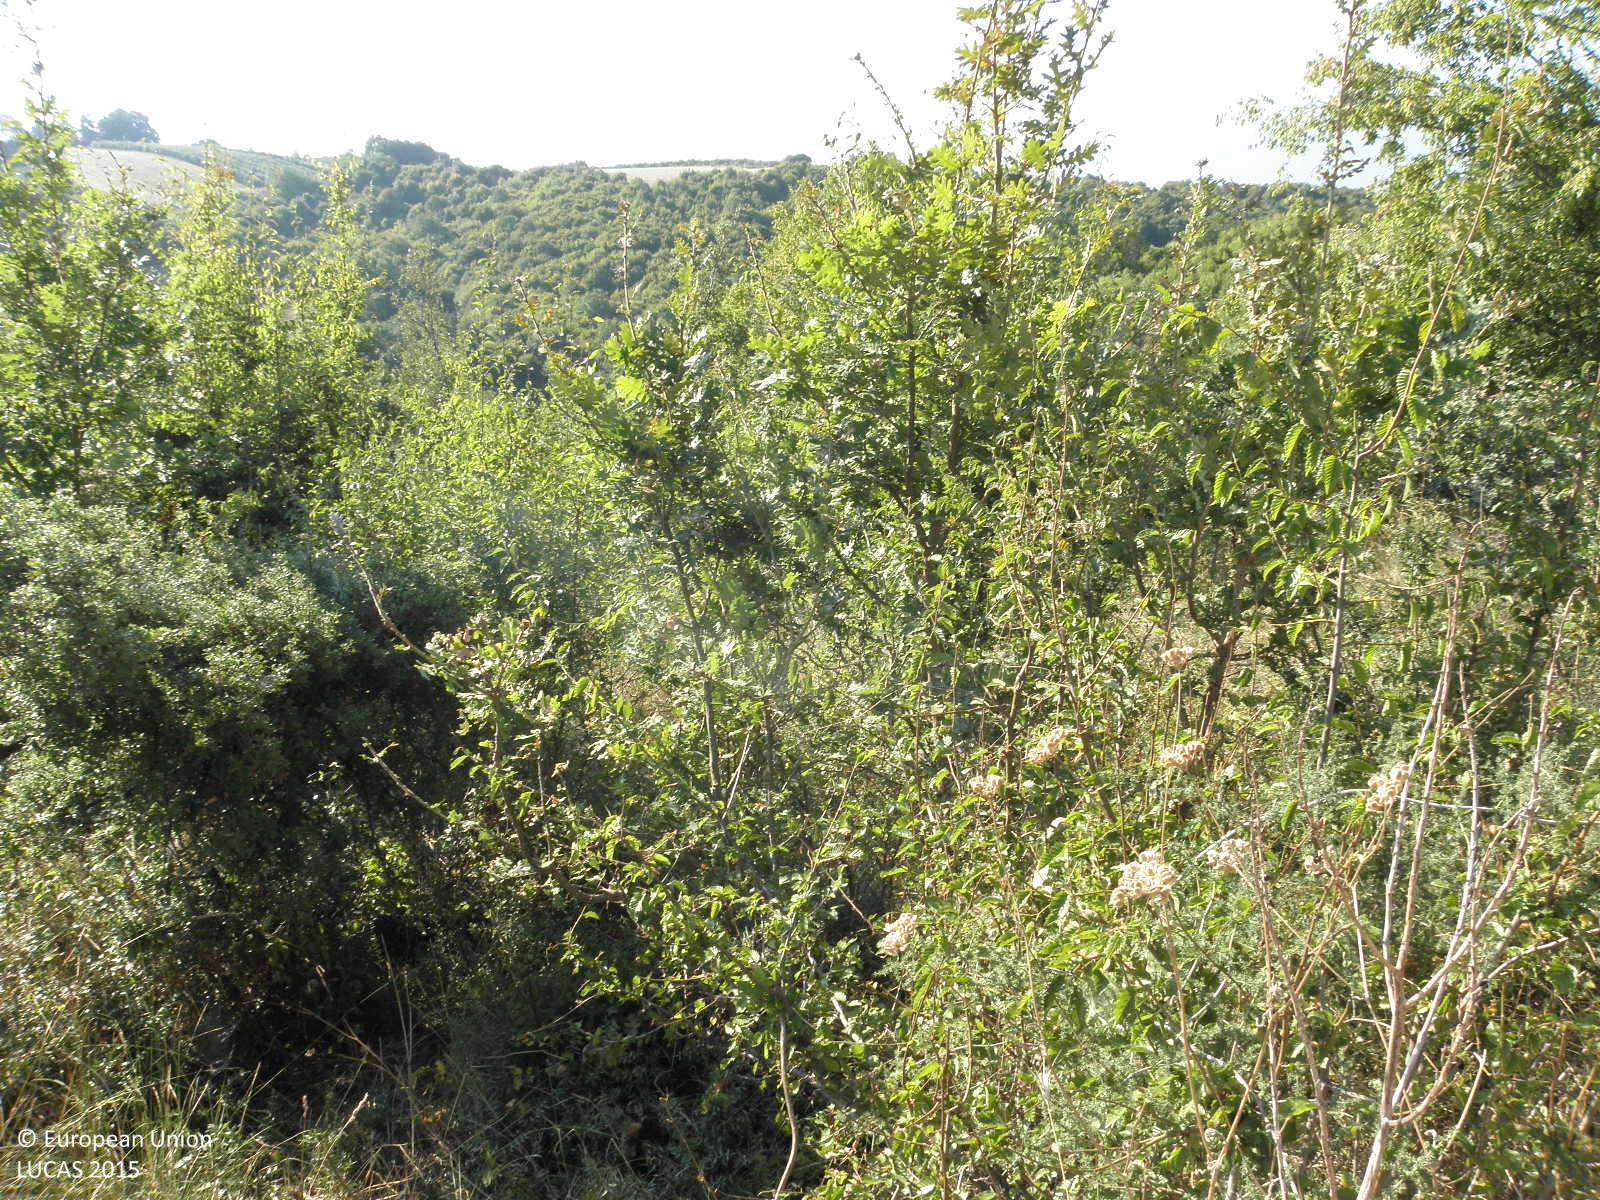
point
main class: Woodland
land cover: Broadleaved woodland
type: thermophilous deciduous forest
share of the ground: 50 - 75 %
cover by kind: broadleaved forest trees 60 %, shrubs 30 %, herbaceous plants 10 %
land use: Semi-natural and natural areas not in use
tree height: > 5 m
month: September
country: GR
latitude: 40.2394
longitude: 22.4451
